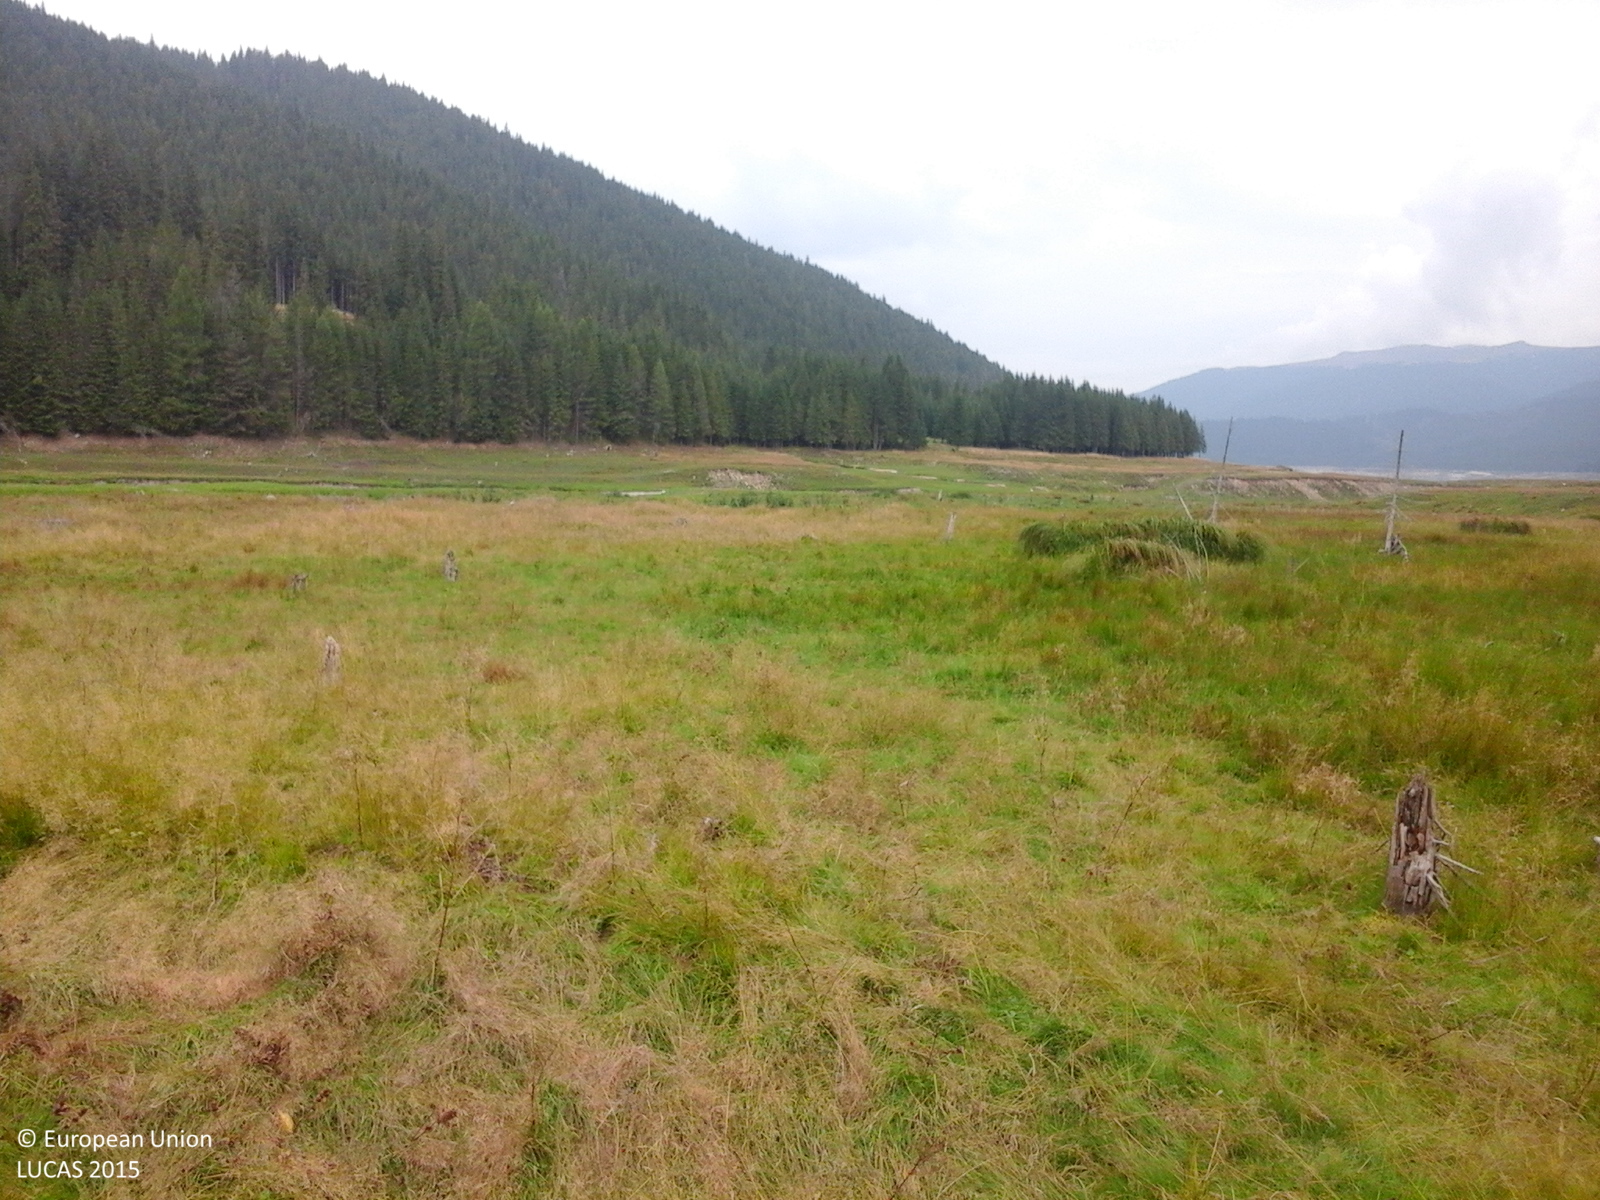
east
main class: Grassland
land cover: Grassland without tree/shrub cover
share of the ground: > 75 %
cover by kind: herbaceous plants 100 %
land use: Agriculture (excluding fallow land and kitchen gardens)
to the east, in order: Grassland without tree/shrub cover
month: September
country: RO
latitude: 45.4312
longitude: 23.6765
